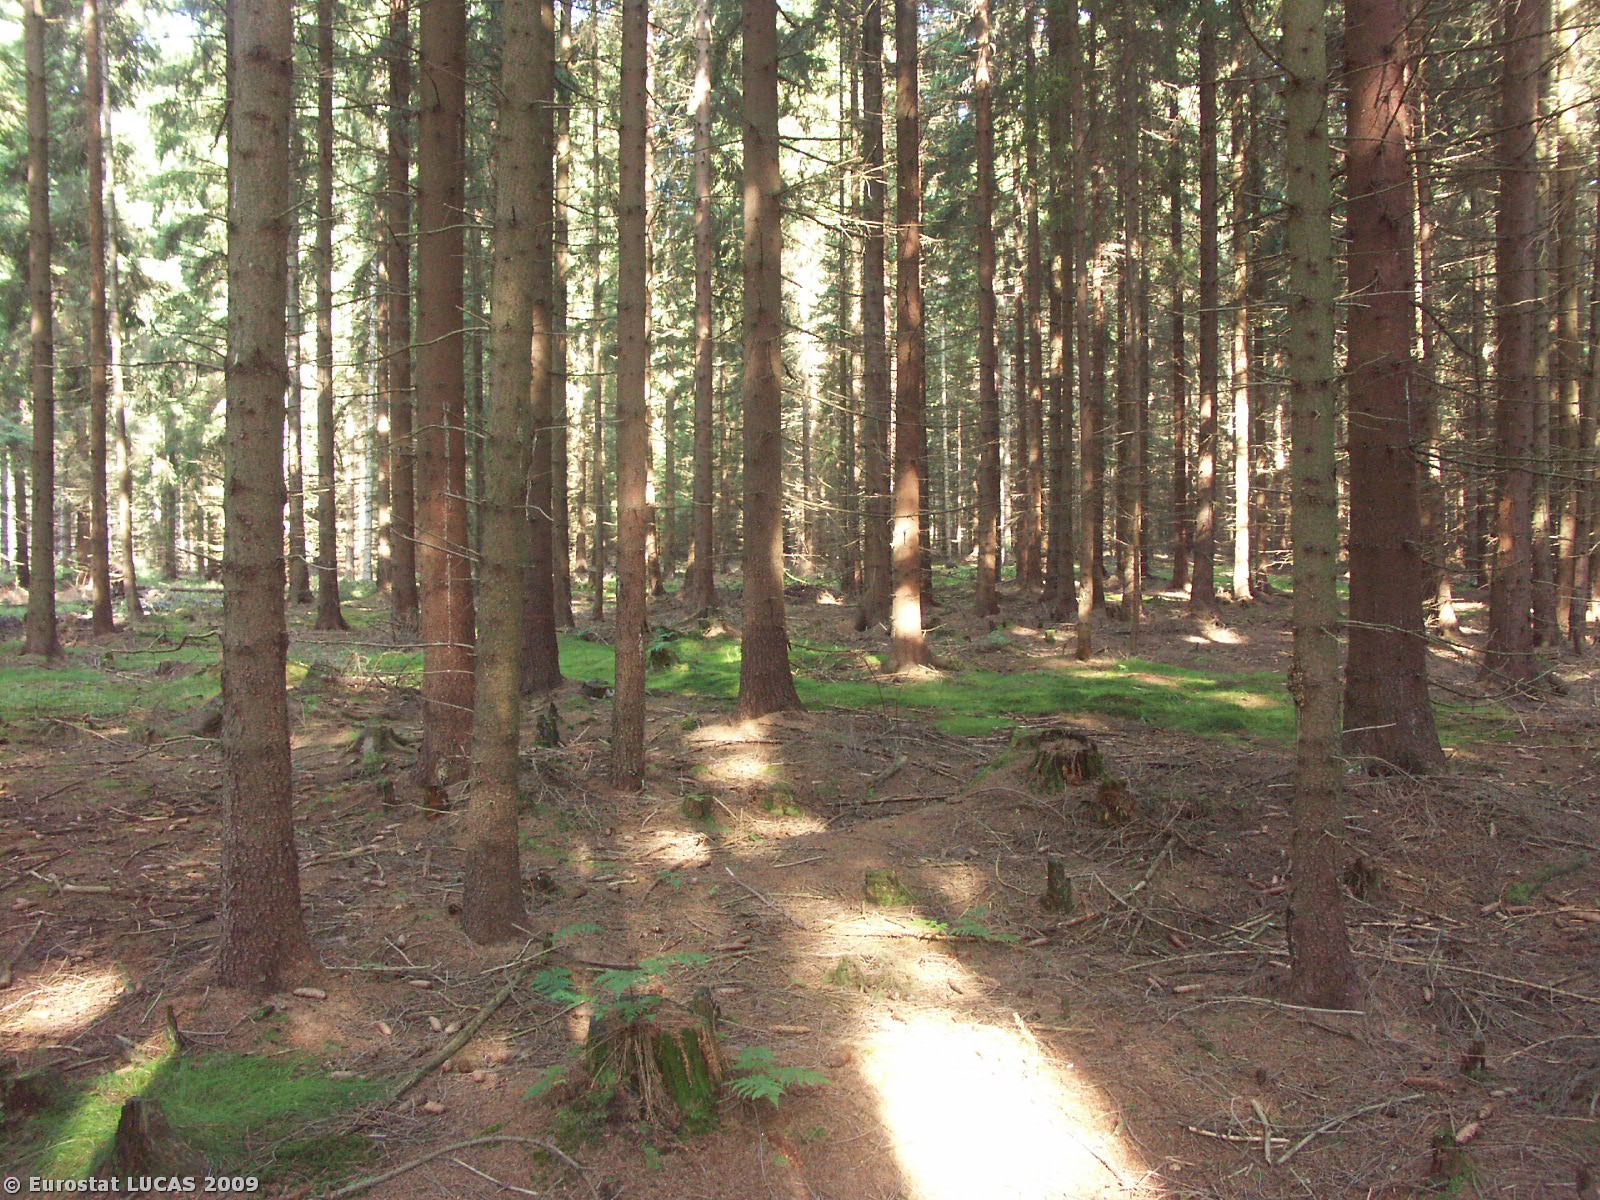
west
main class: Woodland
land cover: Coniferous woodland
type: hemiboreal forest and nemoral coniferous forest and mixed broadleaved-coniferous forest
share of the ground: > 75 %
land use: Forestry
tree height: > 5 m
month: July
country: CZ
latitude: 49.9787
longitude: 17.4167
